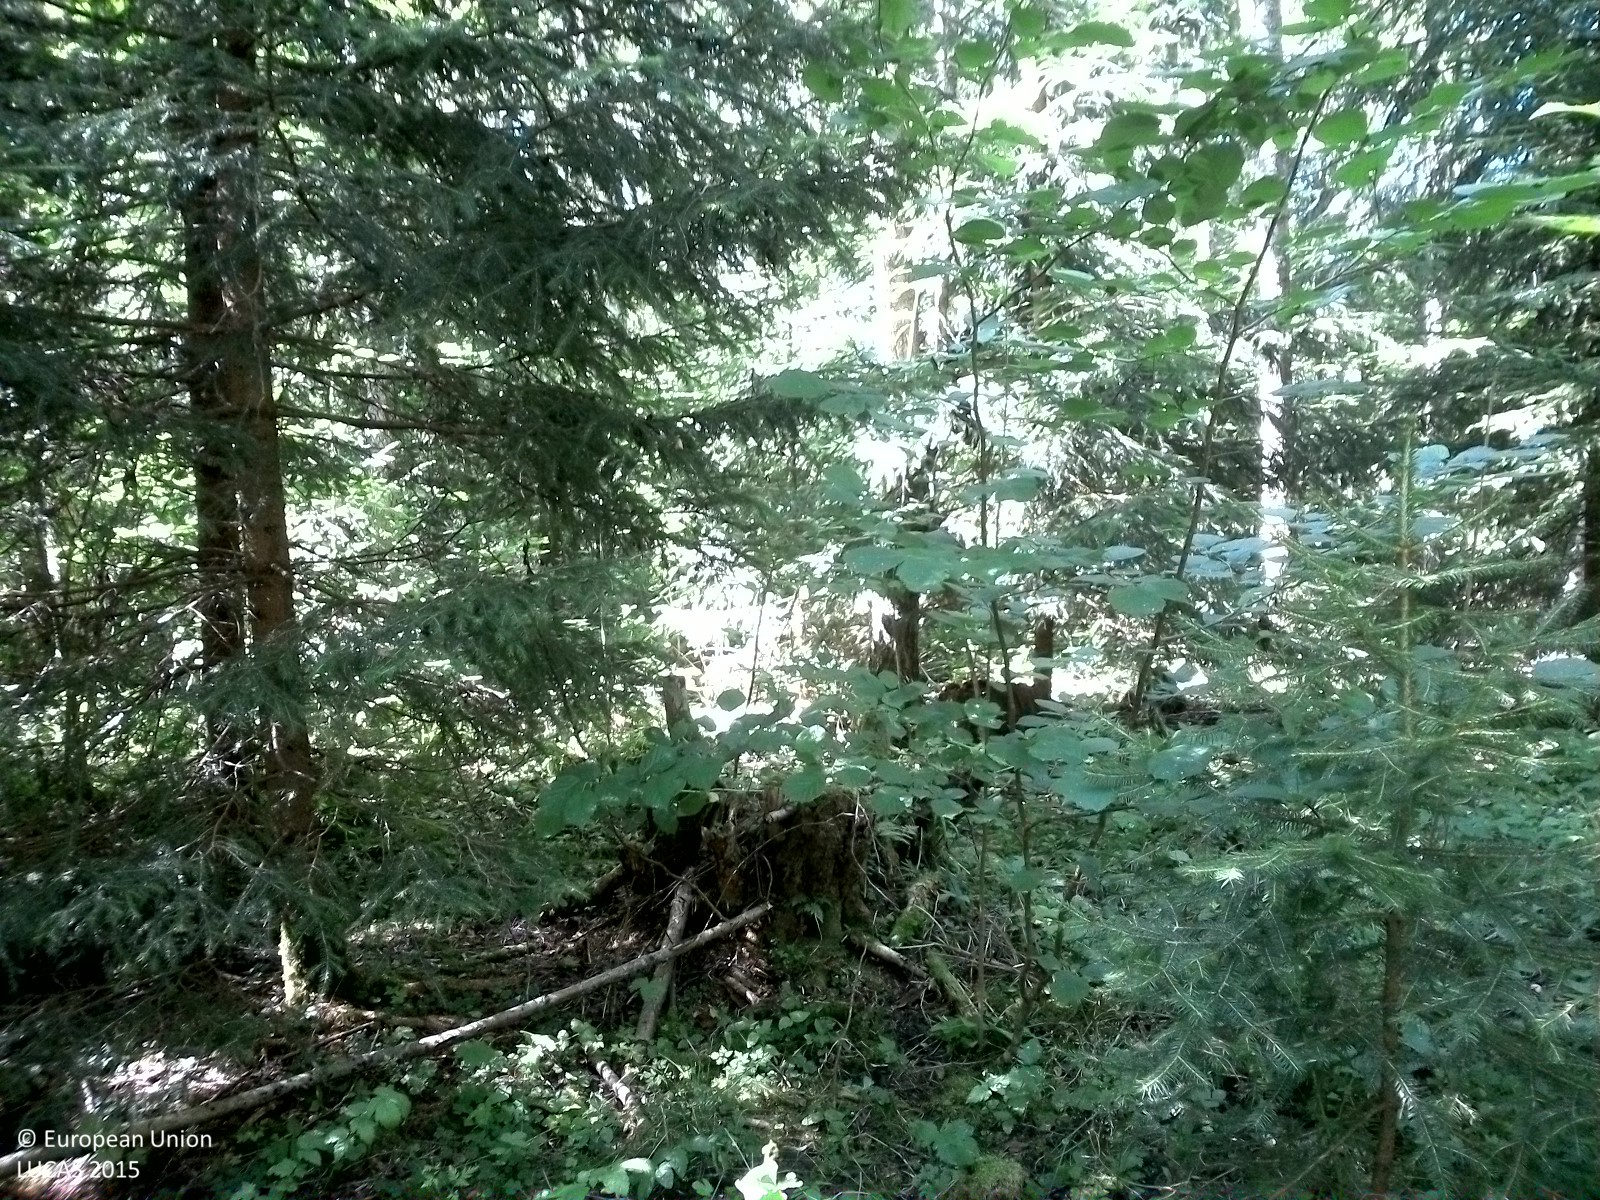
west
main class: Woodland
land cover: Spruce dominated mixed woodland
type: boreal forest
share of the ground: 50 - 75 %
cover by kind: coniferous forest trees 30 %, broadleaved forest trees 25 %, herbaceous plants 20 %, shrubs 15 %, unconsolidated bare surface 10 %
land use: Forestry
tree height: > 5 m
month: August
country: SE
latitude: 59.2579
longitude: 15.5868
